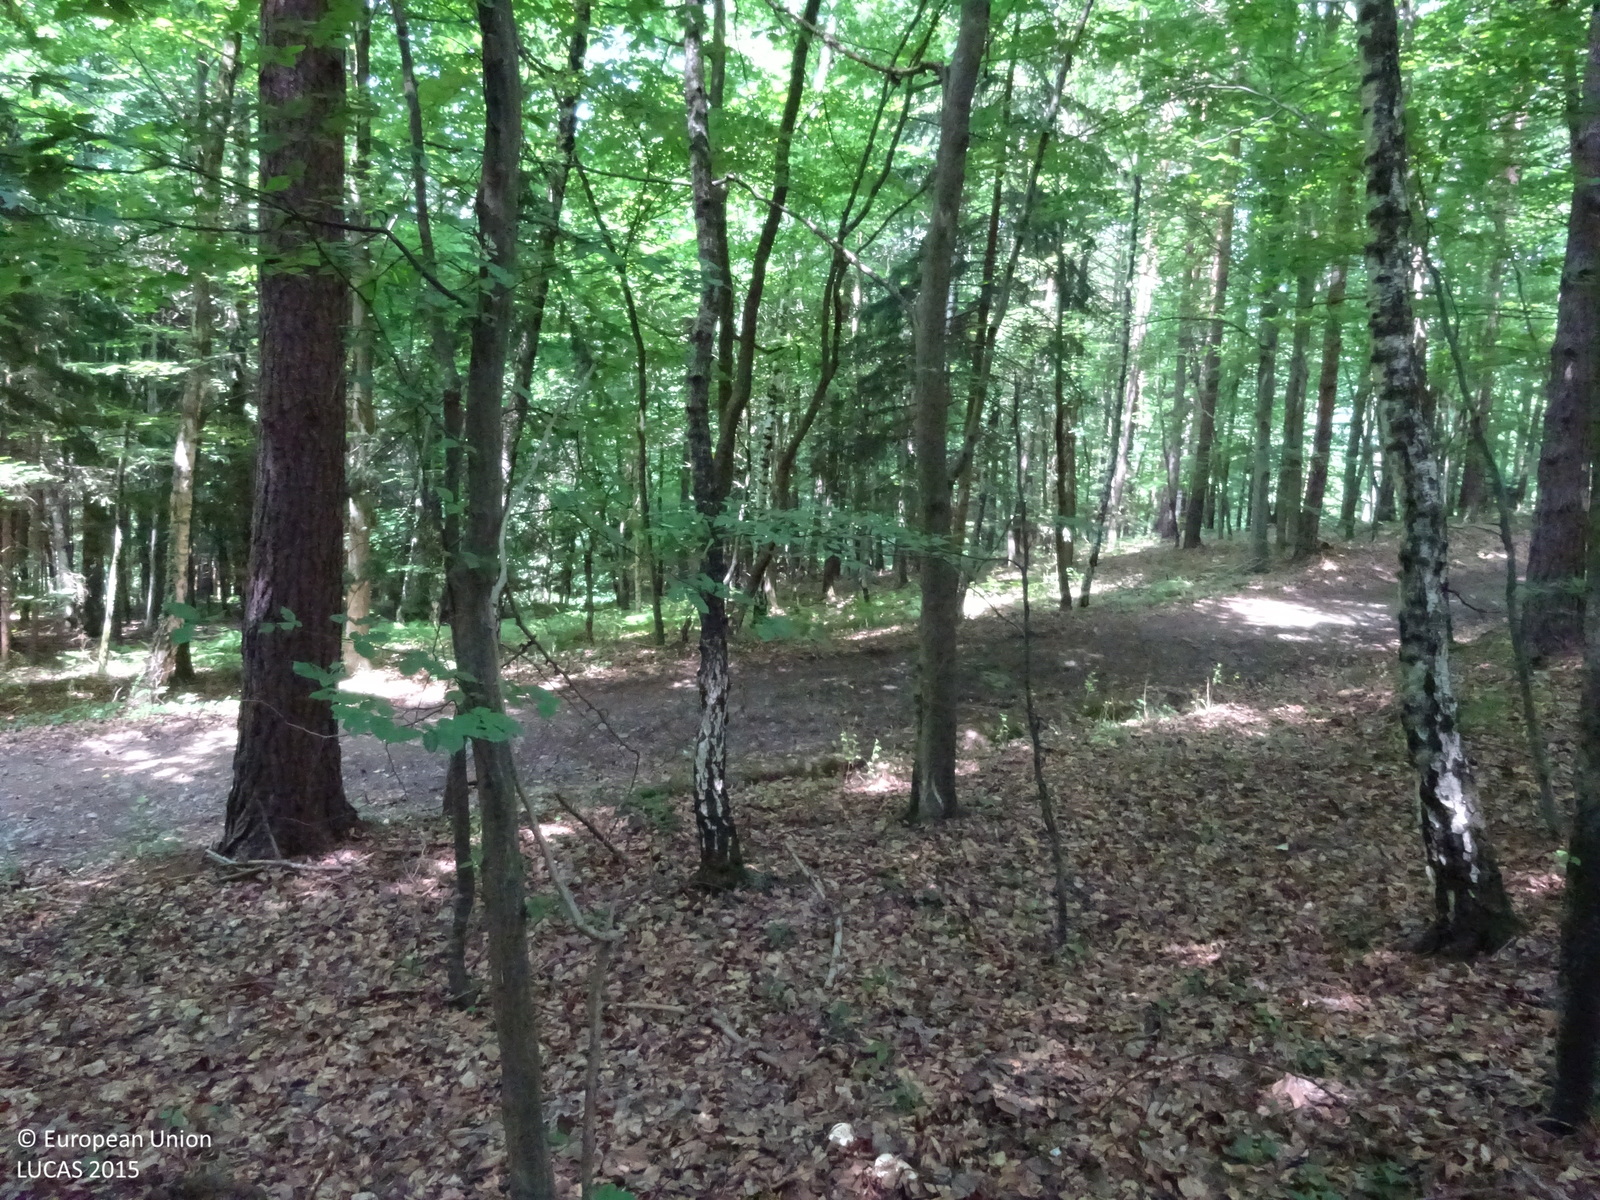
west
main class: Woodland
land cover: Pine dominated mixed woodland
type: hemiboreal forest and nemoral coniferous forest and mixed broadleaved-coniferous forest
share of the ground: > 75 %
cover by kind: broadleaved forest trees 75 %, coniferous forest trees 25 %
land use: Forestry
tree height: > 5 m
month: June
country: AT
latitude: 46.8541
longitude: 15.9418
